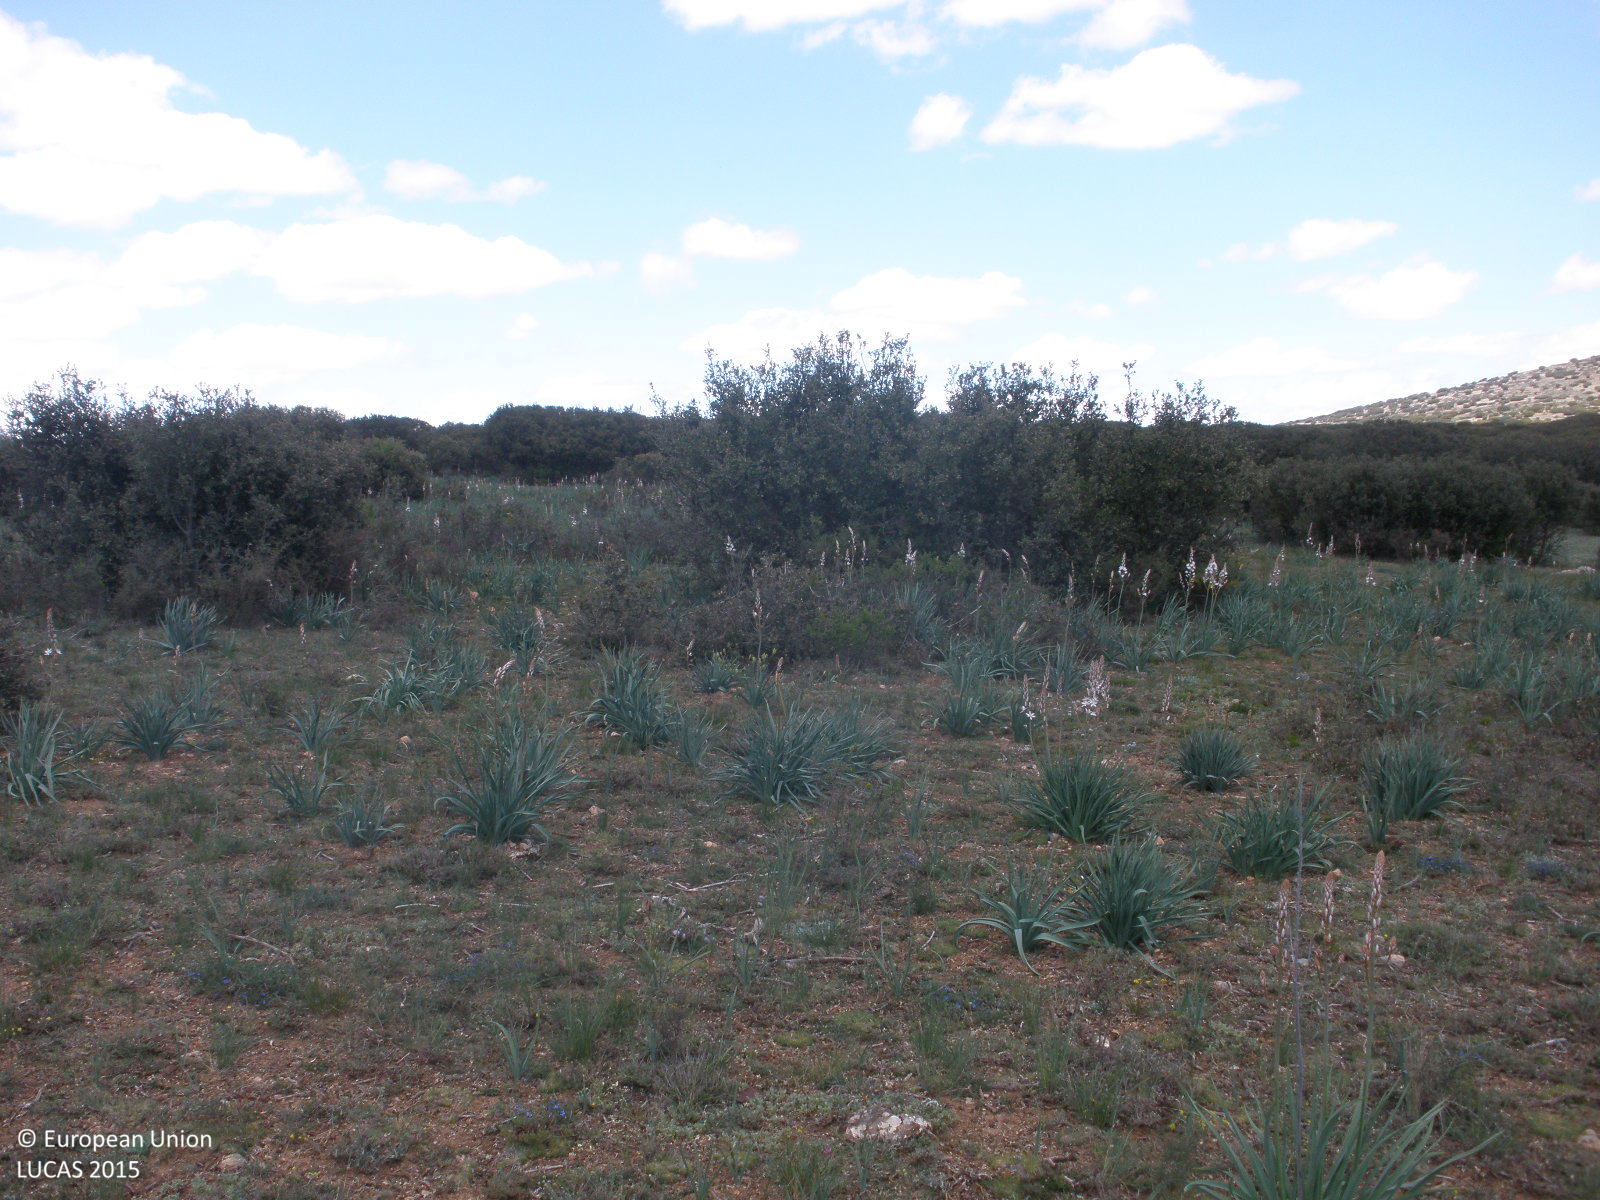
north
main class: Shrubland
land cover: Shrubland with sparse tree cover
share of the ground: 50 - 75 %
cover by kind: shrubs 55 %, herbaceous plants 30 %, consolidated bare surface 10 %, coniferous forest trees 5 %
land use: Semi-natural and natural areas not in use
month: May
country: ES
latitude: 40.7137
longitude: -1.0822
